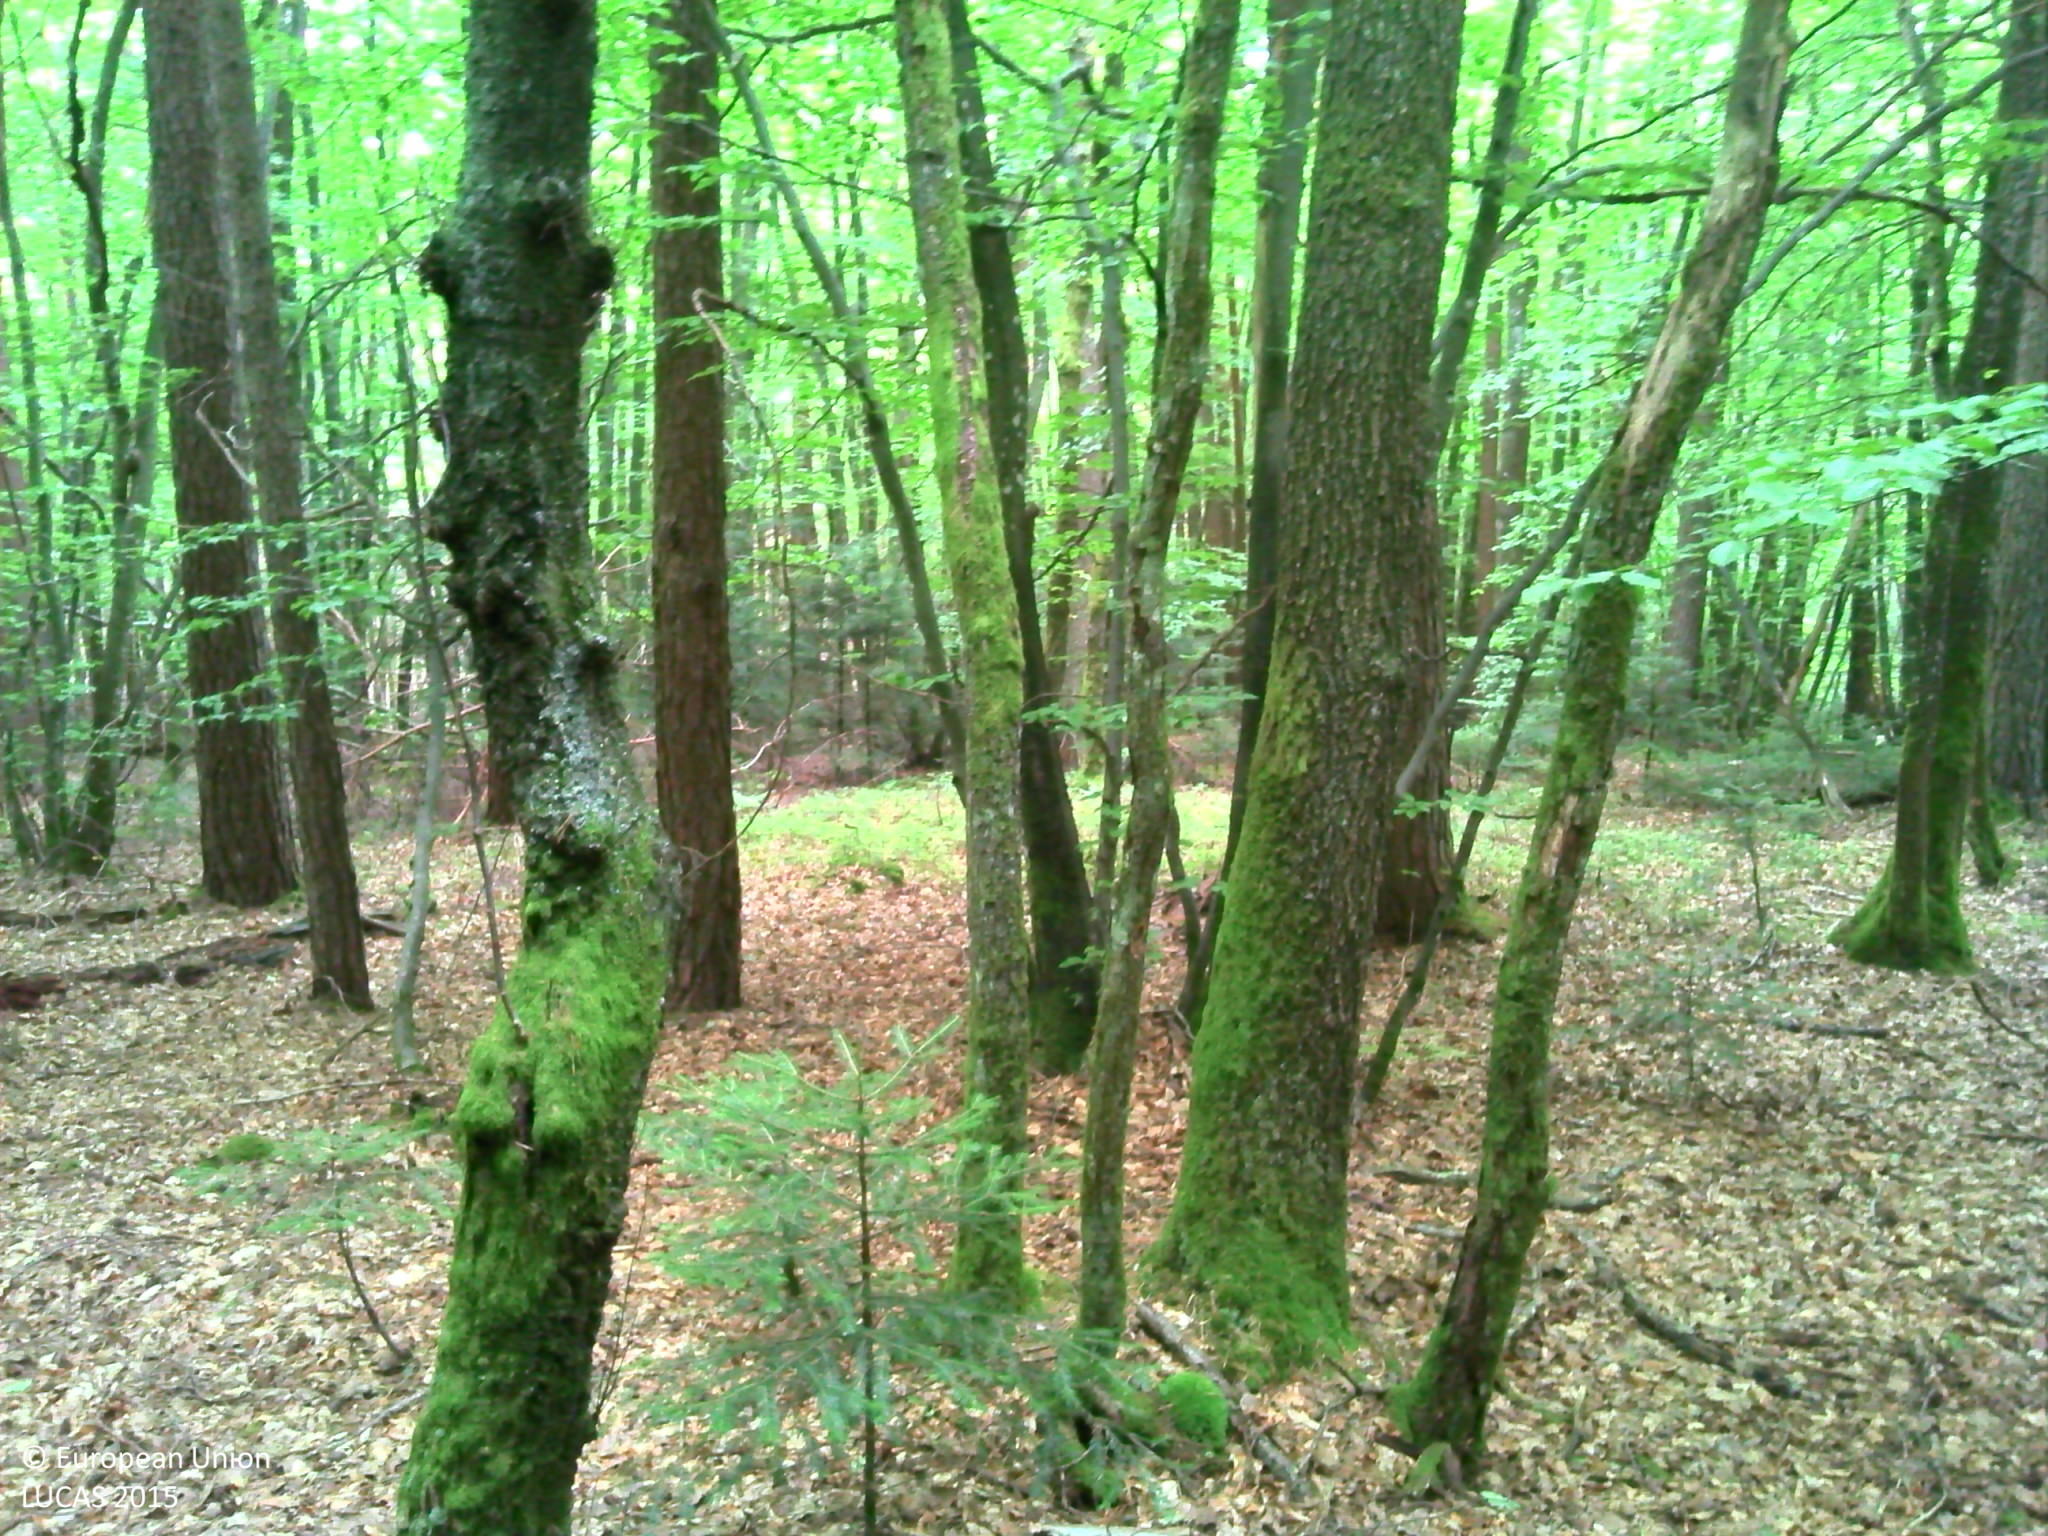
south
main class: Woodland
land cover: Spruce dominated mixed woodland
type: mesophytic deciduous forest
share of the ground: > 75 %
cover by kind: coniferous forest trees 55 %, broadleaved forest trees 25 %, herbaceous plants 10 %
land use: Forestry
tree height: > 5 m
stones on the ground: < 10 %
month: August
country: FR
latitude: 46.2247
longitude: 4.4399
